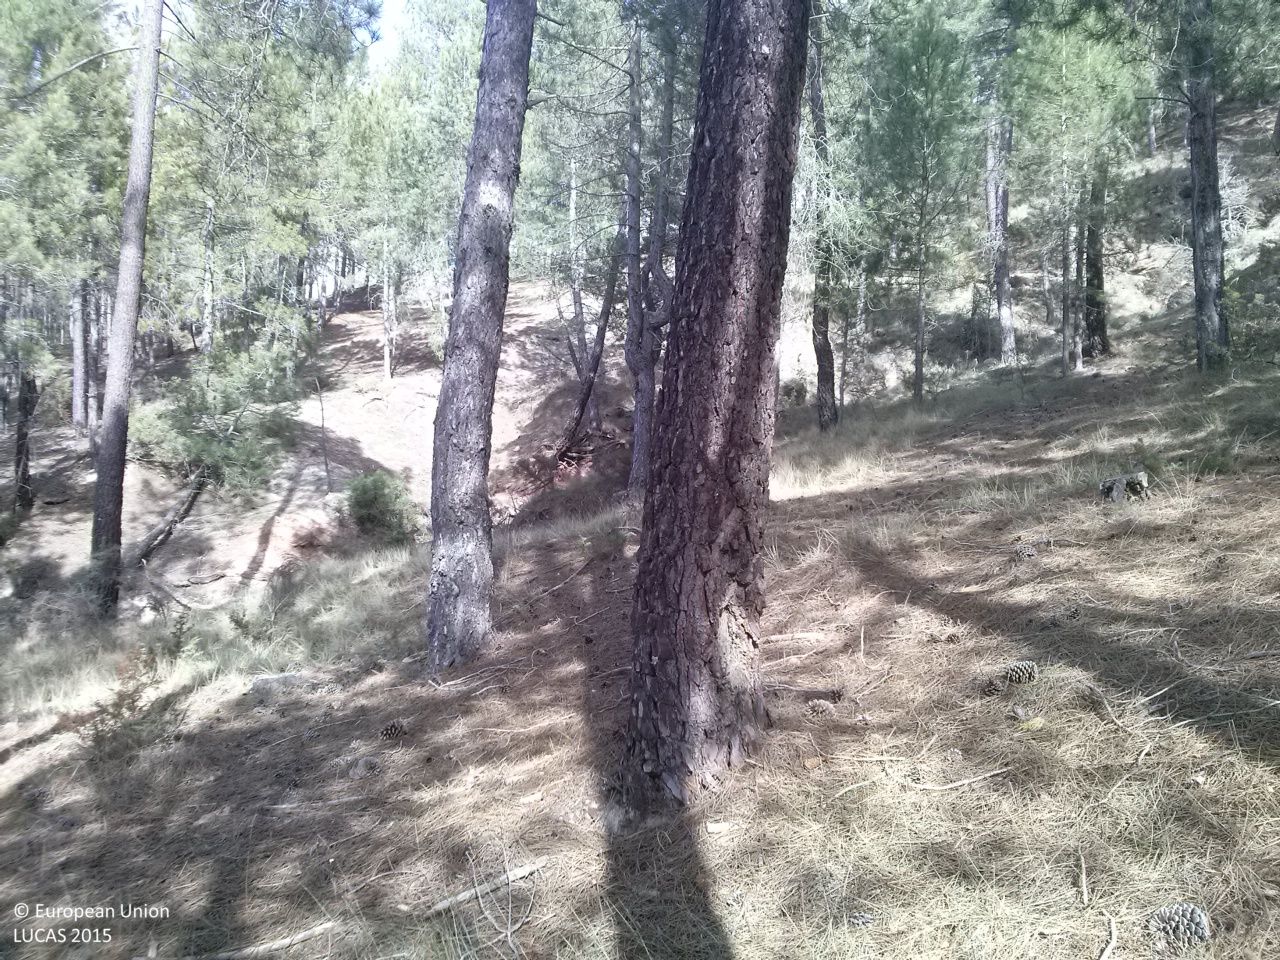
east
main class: Woodland
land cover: Pine dominated coniferous woodland
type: coniferous forest of the mediterranean region
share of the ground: 50 - 75 %
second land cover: Grassland without tree/shrub cover
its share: 10 - 25 %
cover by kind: coniferous forest trees 65 %, herbaceous plants 25 %, unconsolidated bare surface 10 %
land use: Forestry
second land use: Agriculture (excluding fallow land and kitchen gardens)
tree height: > 5 m
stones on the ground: < 10 %
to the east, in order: Pine dominated coniferous woodland; Grassland without tree/shrub cover; Pine dominated coniferous woodland; Other bare soil; Pine dominated coniferous woodland
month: April
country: ES
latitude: 40.1376
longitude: -1.6436
